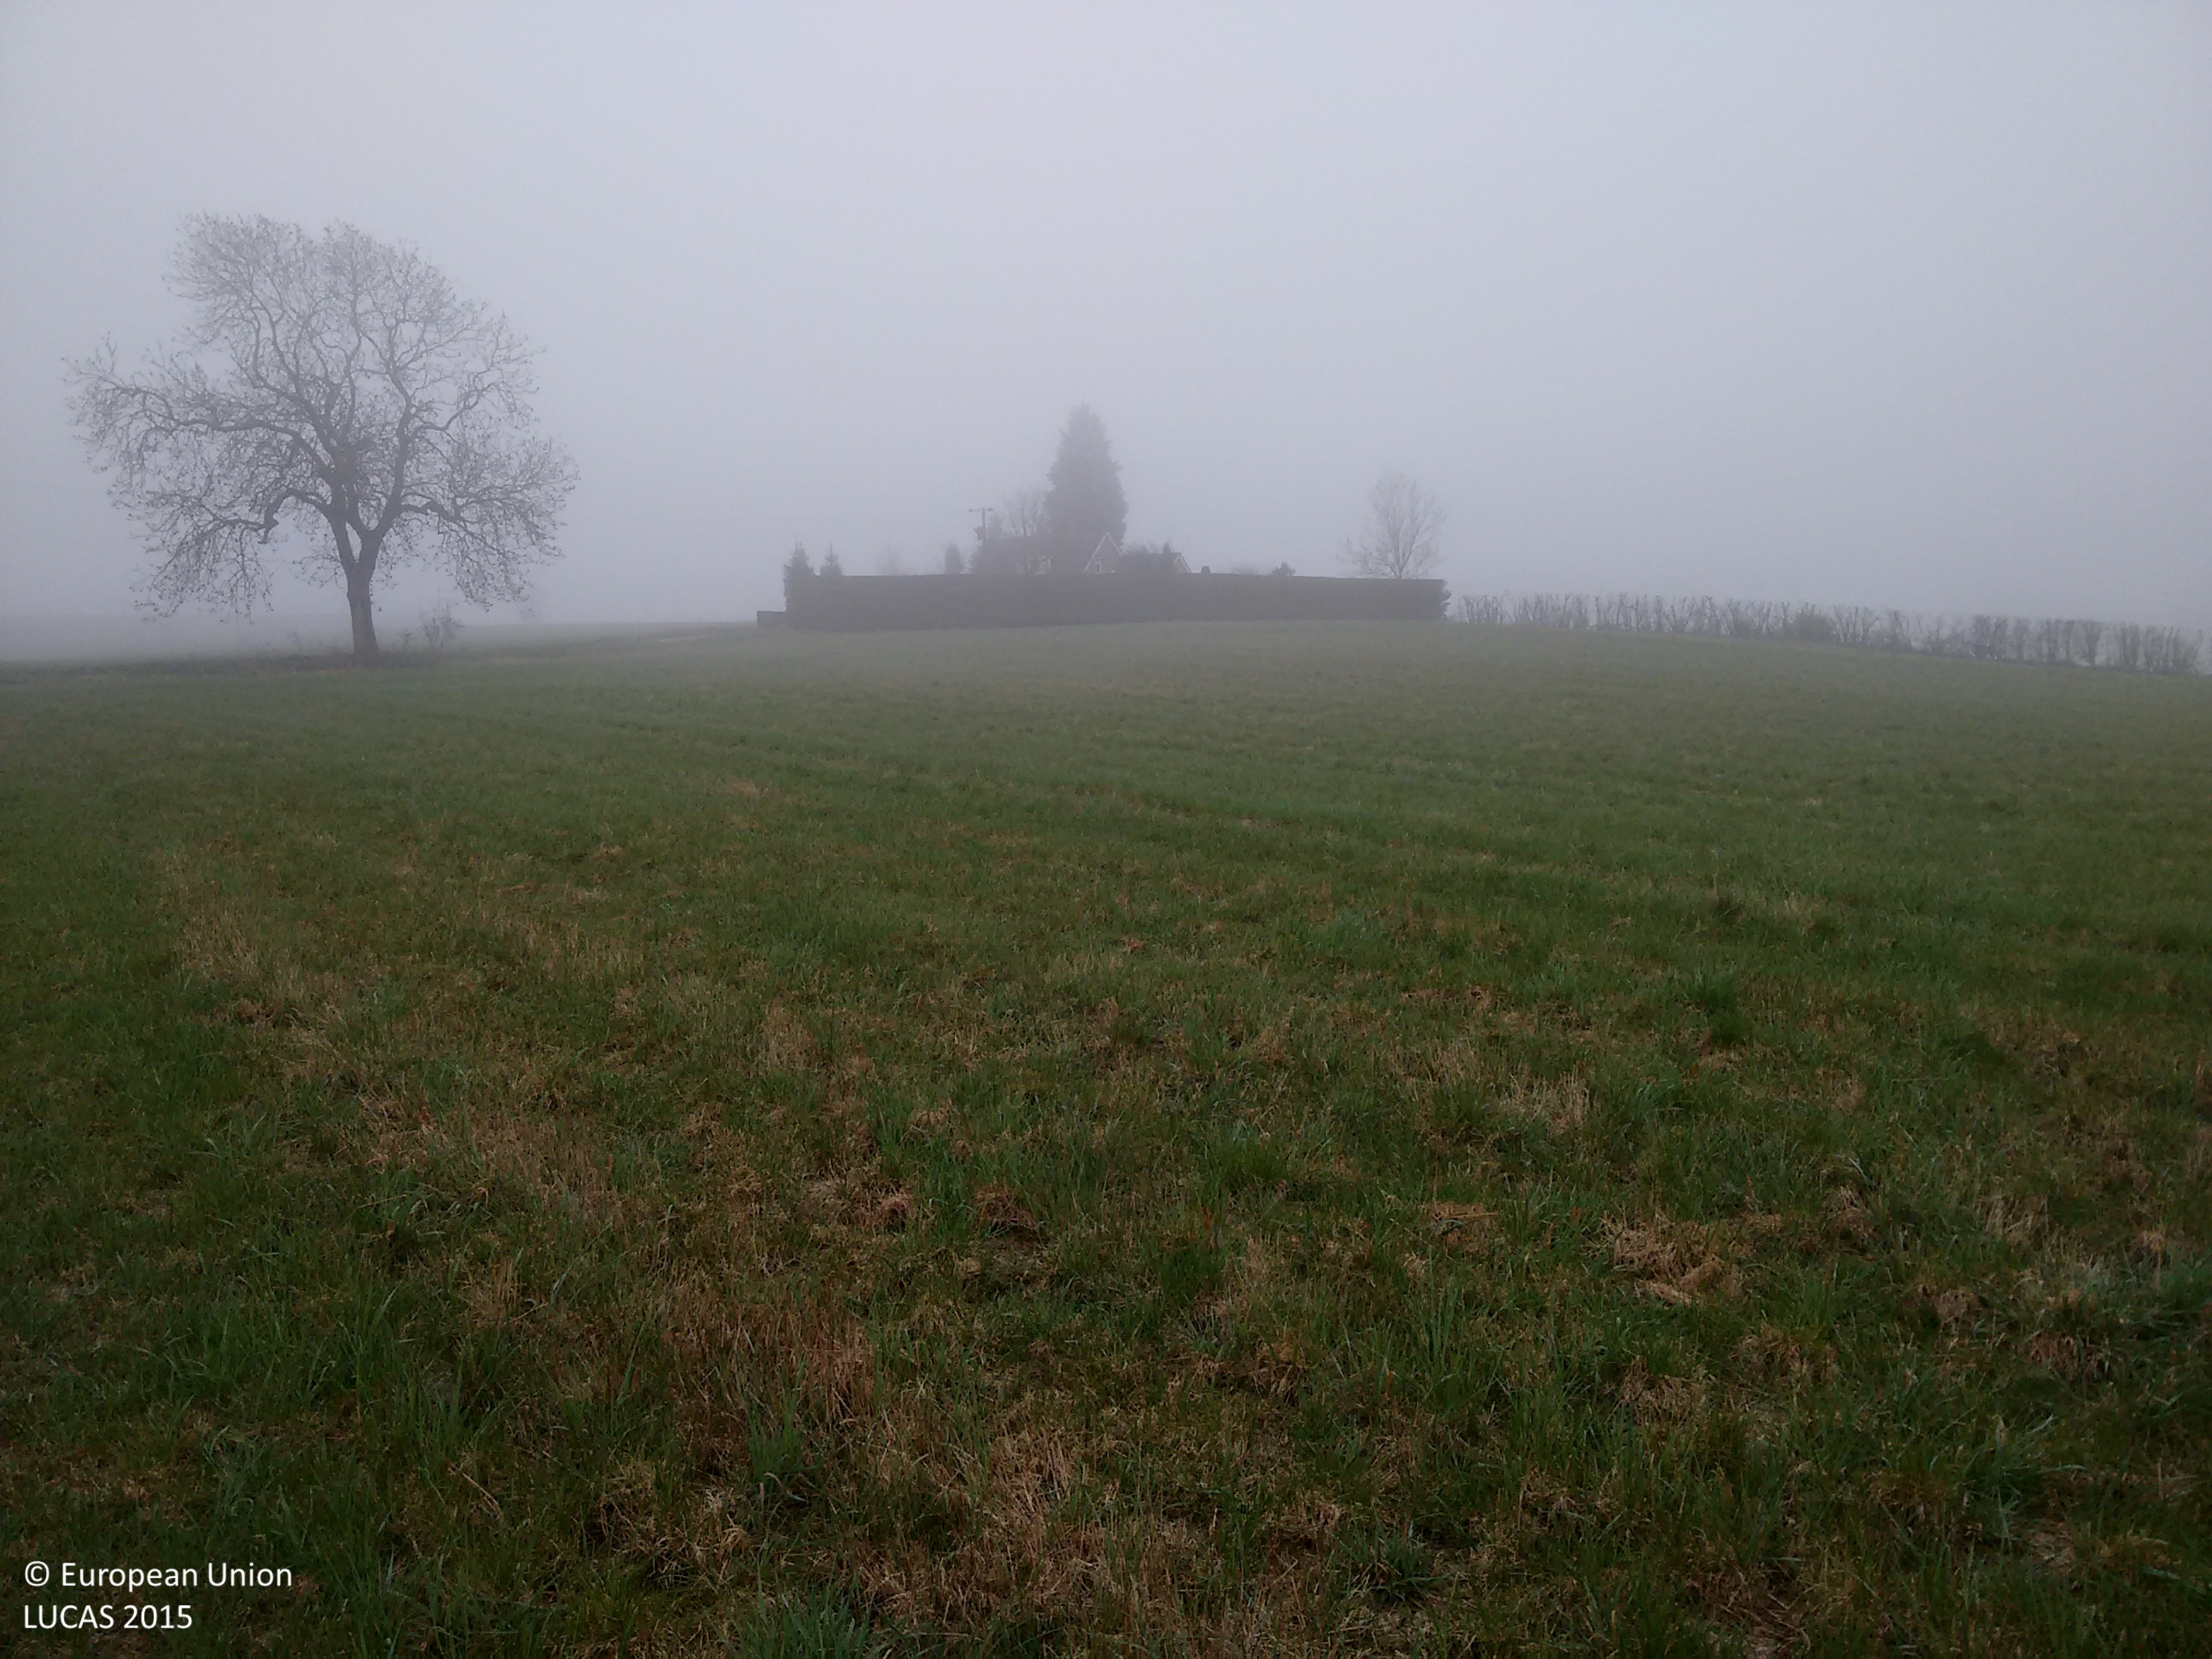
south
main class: Cropland
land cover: Temporary grasslands
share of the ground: > 75 %
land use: Agriculture (excluding fallow land and kitchen gardens)
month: April
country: GB
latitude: 53.9833
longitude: -0.8527
